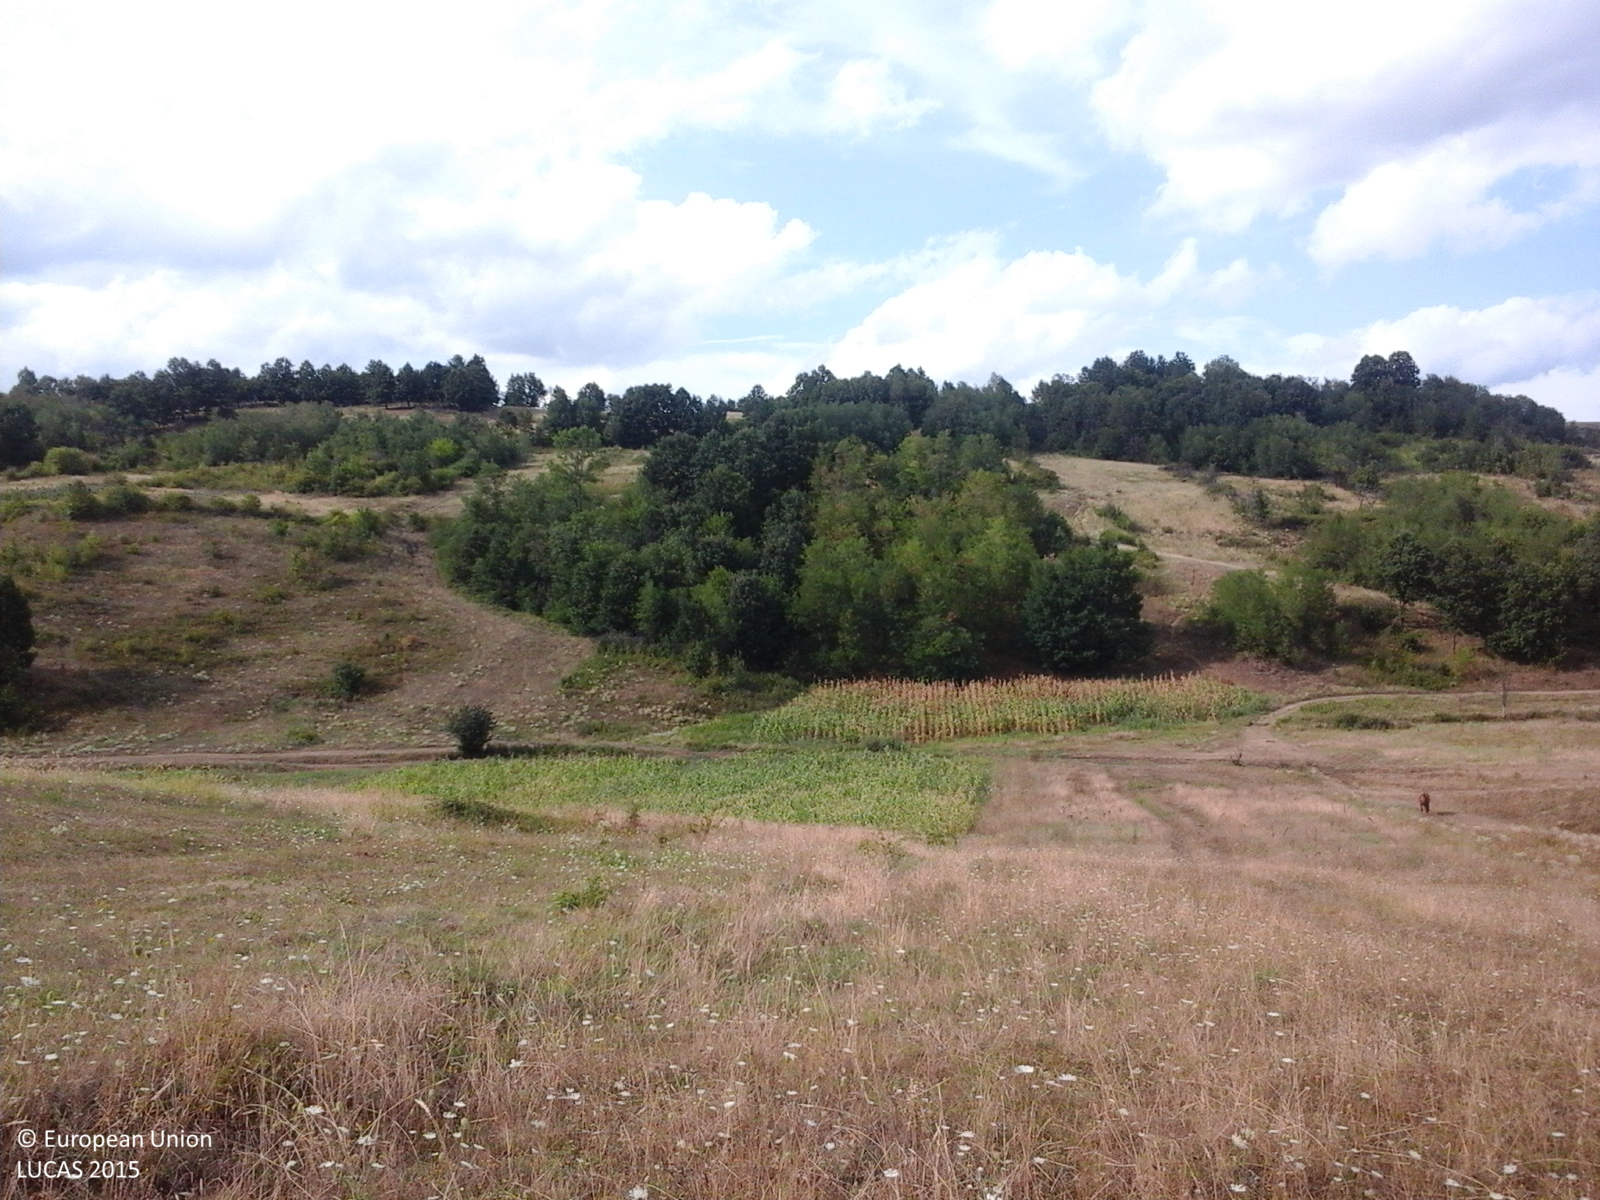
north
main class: Grassland
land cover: Grassland without tree/shrub cover
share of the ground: > 75 %
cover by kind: herbaceous plants 100 %
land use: Agriculture (excluding fallow land and kitchen gardens)
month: August
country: RO
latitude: 44.6404
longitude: 22.8662
